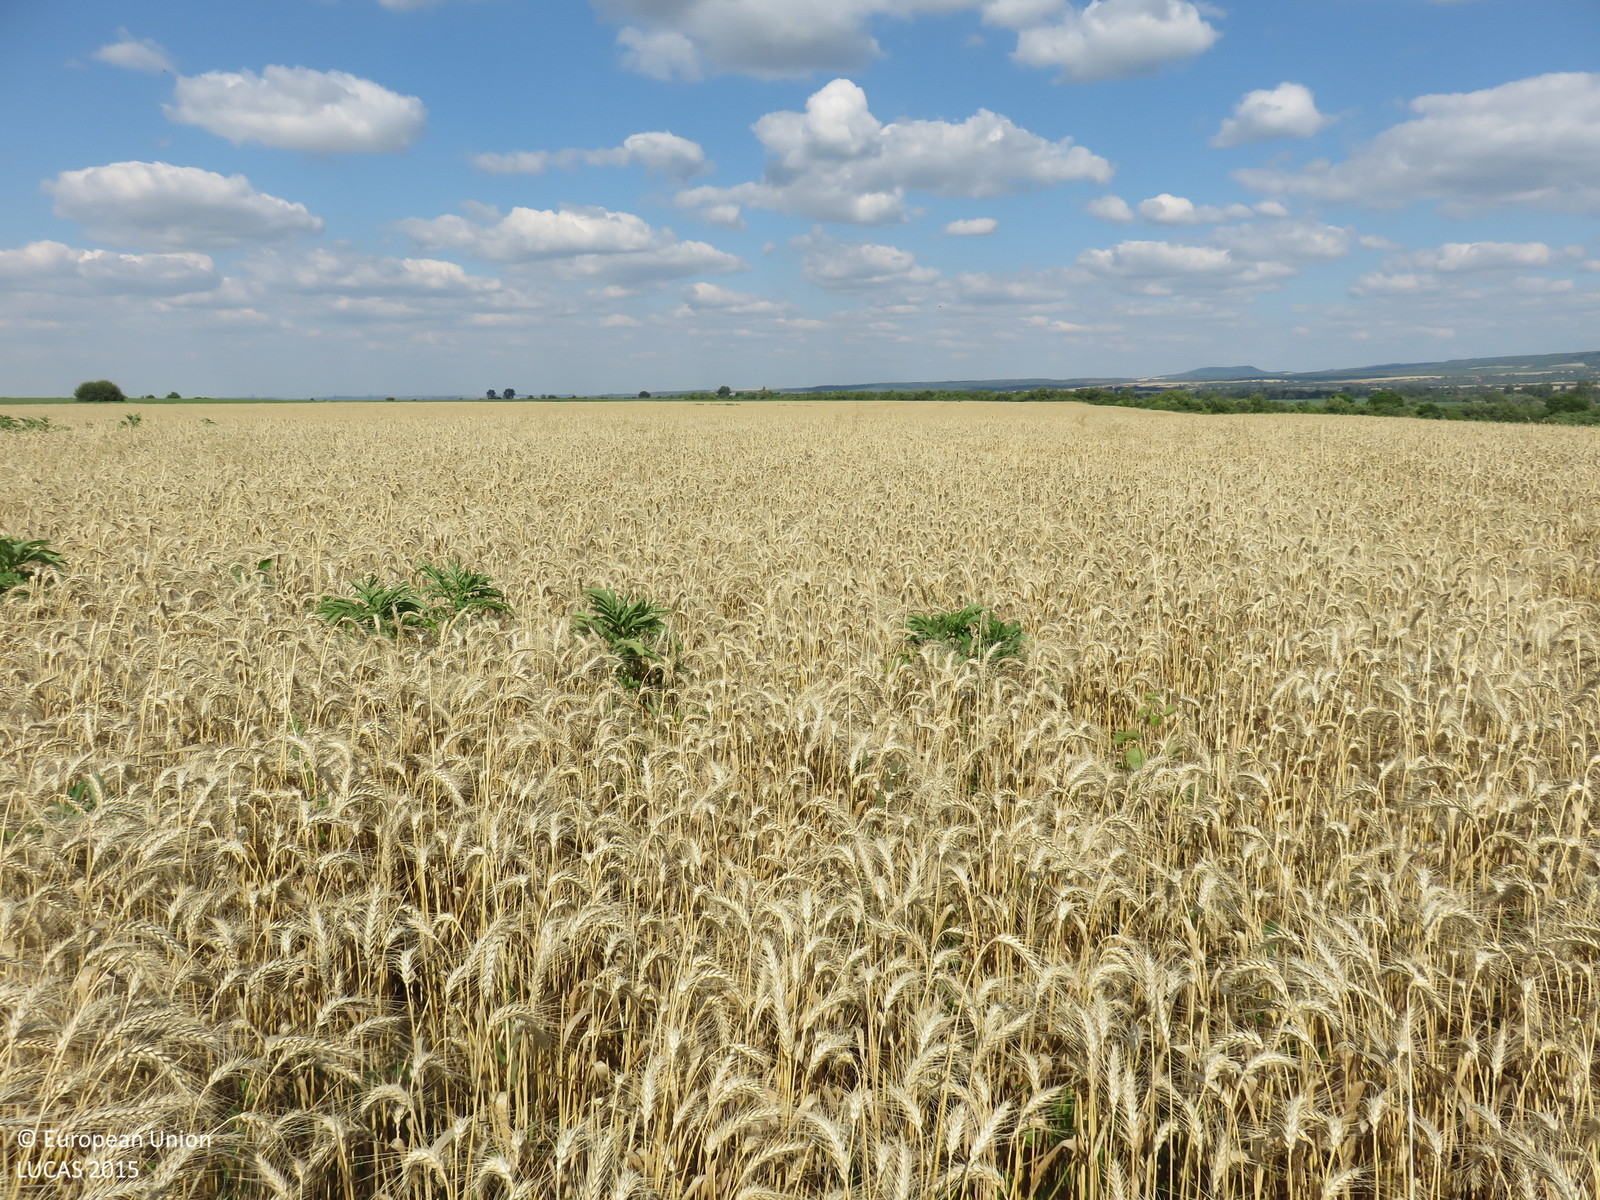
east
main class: Cropland
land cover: Common wheat
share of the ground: > 75 %
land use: Agriculture (excluding fallow land and kitchen gardens)
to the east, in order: Common wheat
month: June
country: BG
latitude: 43.2763
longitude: 24.9656
